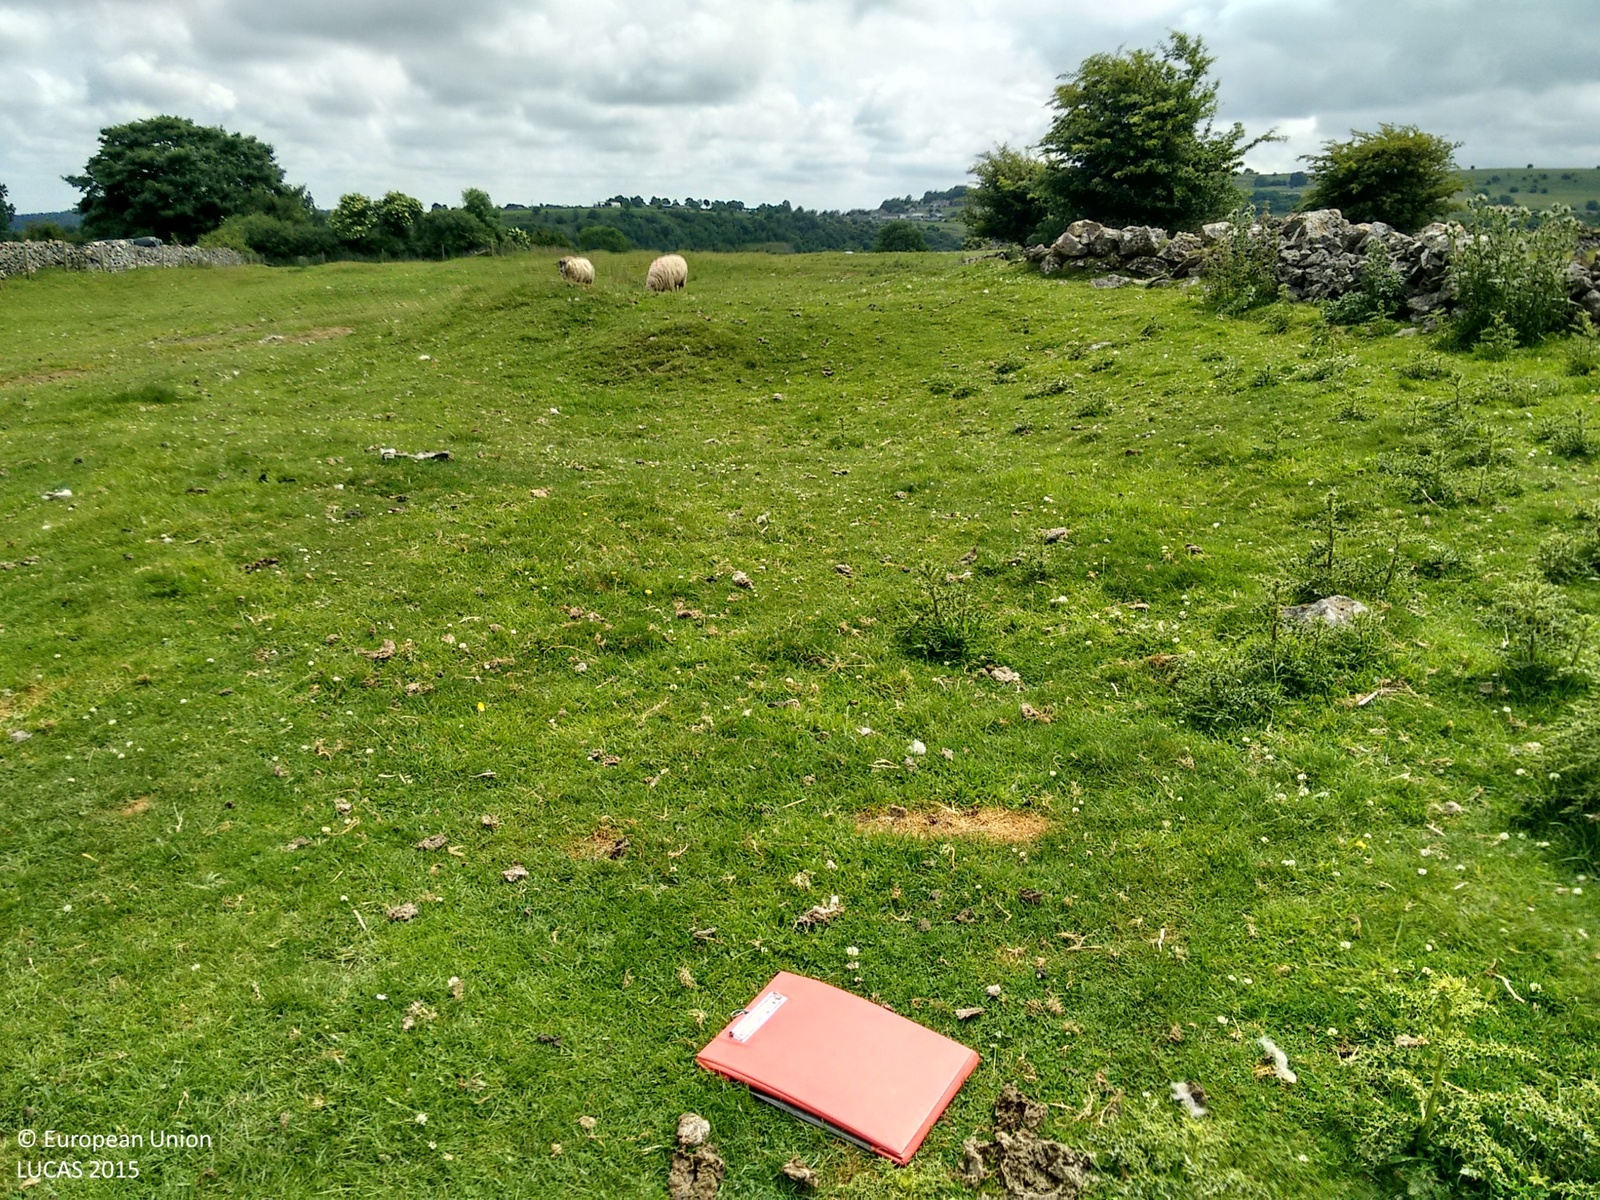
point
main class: Grassland
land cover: Grassland without tree/shrub cover
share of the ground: > 75 %
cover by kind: herbaceous plants 100 %
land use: Agriculture (excluding fallow land and kitchen gardens)
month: July
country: GB
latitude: 53.1148
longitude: -1.6007
